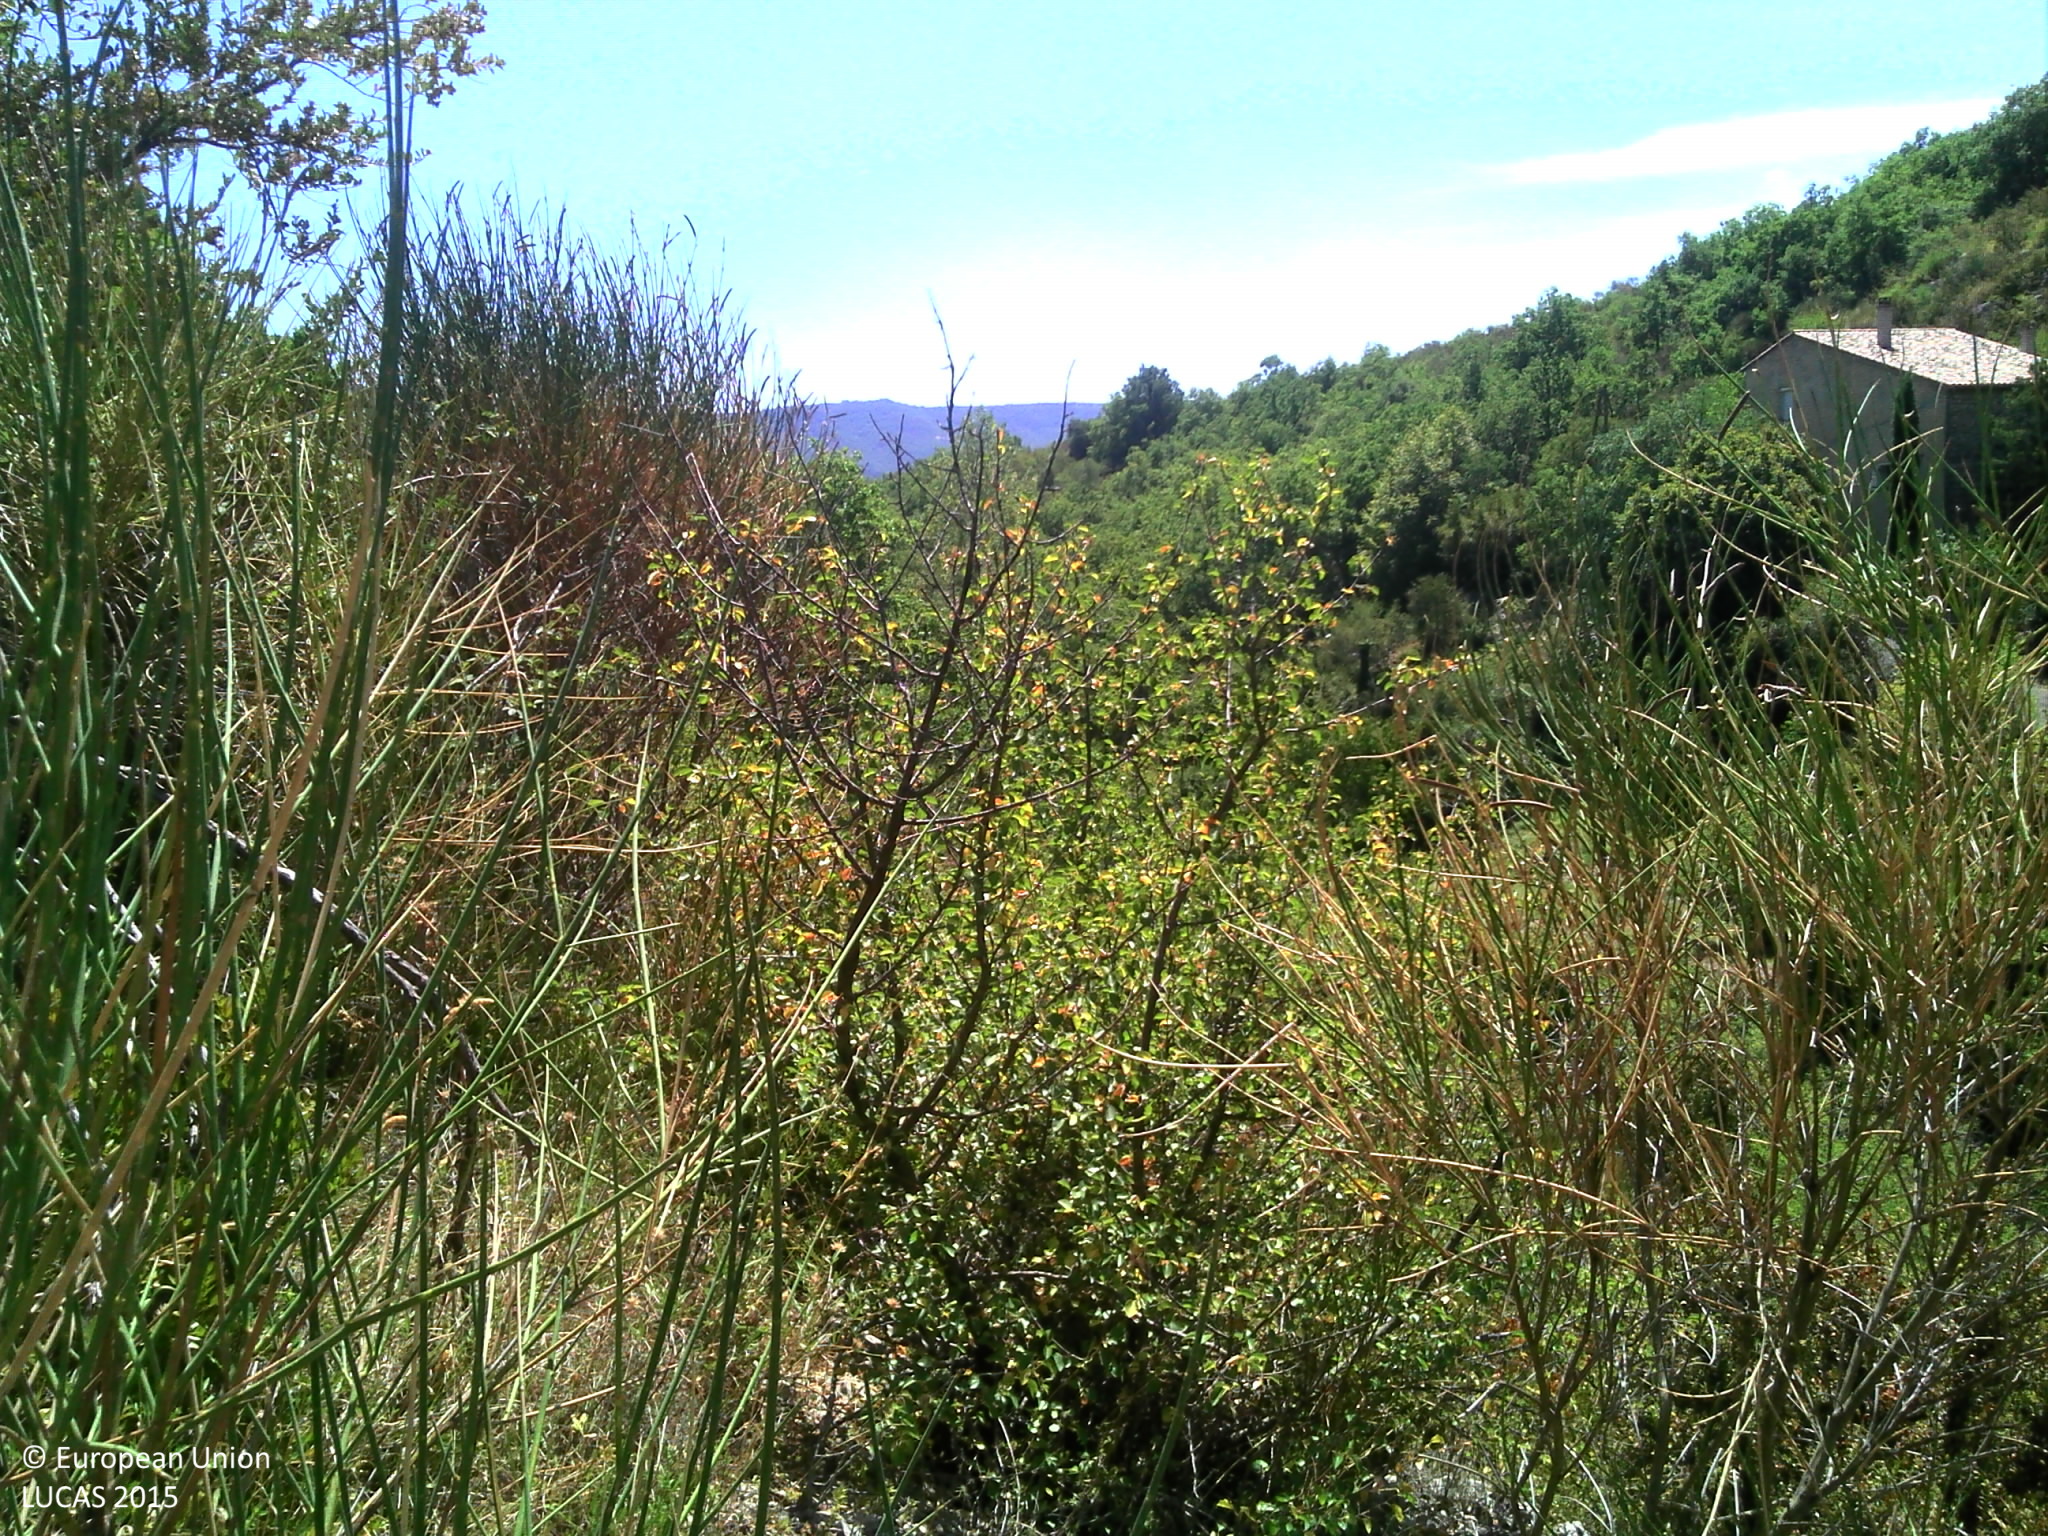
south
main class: Shrubland
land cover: Shrubland with sparse tree cover
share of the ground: > 75 %
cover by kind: shrubs 90 %, broadleaved forest trees 5 %, unconsolidated bare surface 5 %
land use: Semi-natural and natural areas not in use
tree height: < 5 m
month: July
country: FR
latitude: 44.7180
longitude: 4.6409
